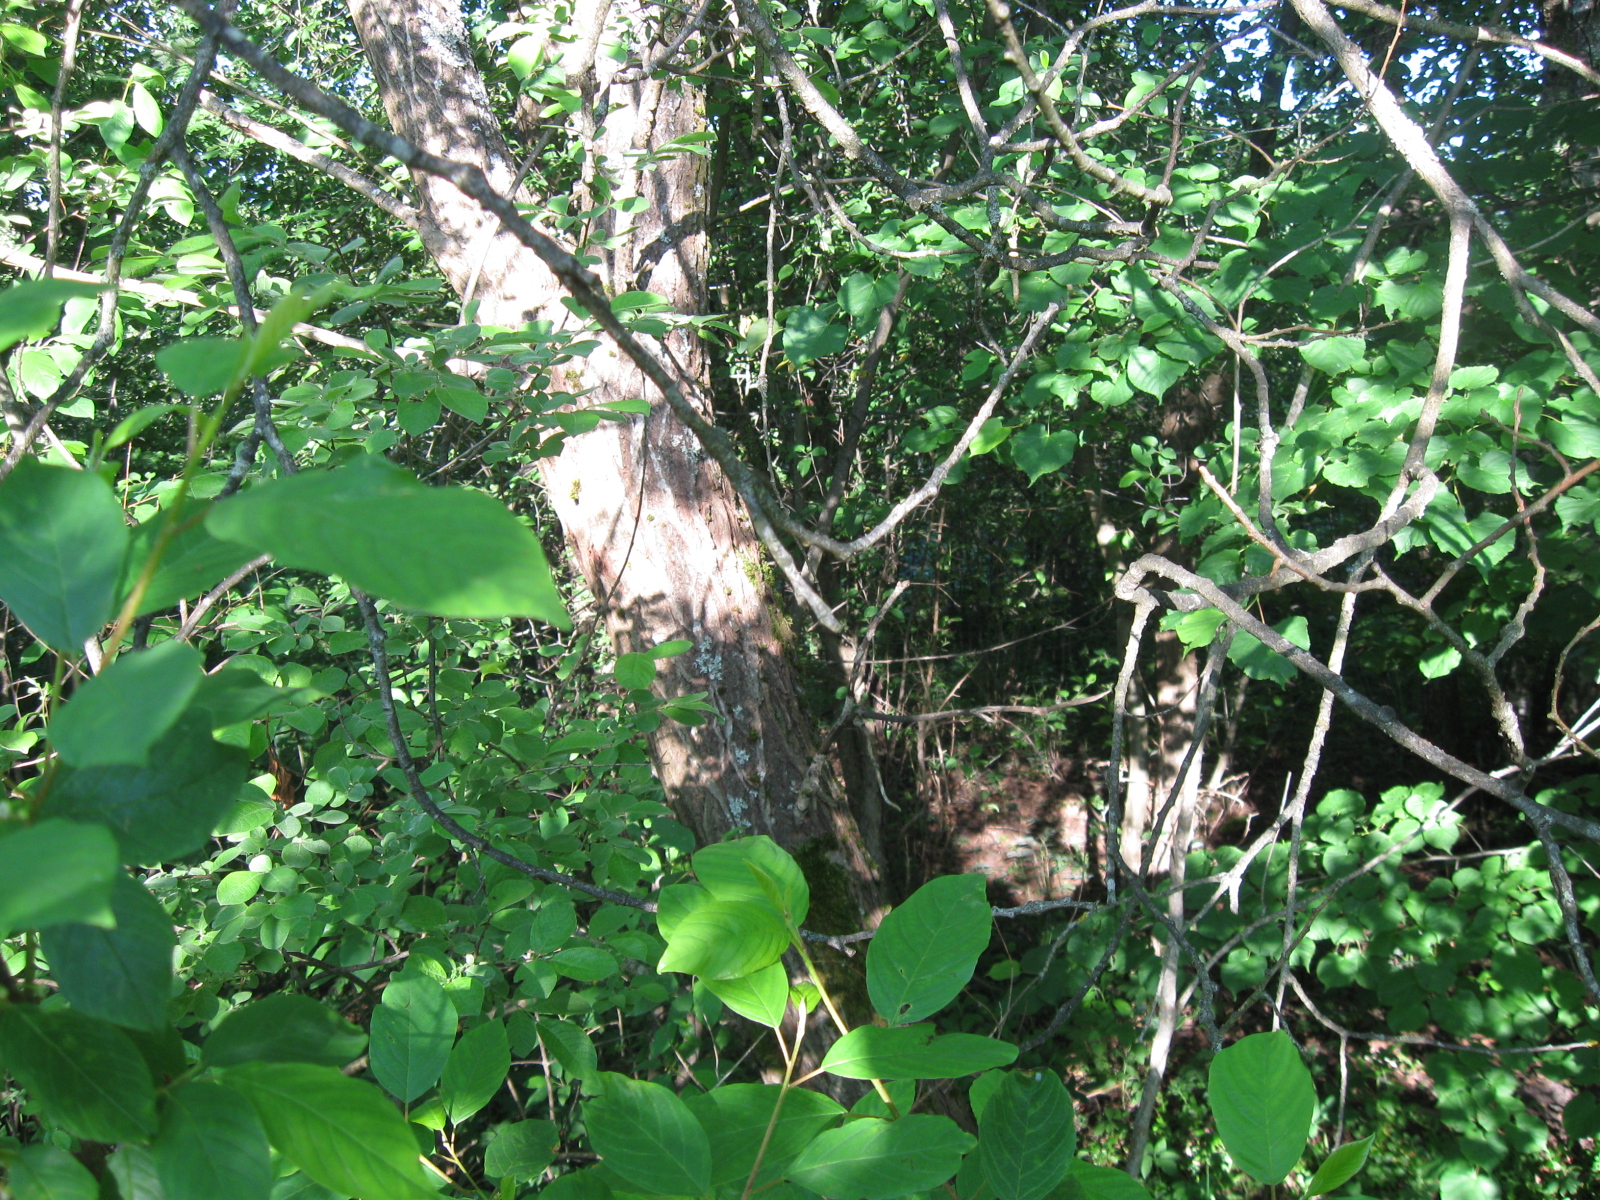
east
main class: Woodland
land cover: Broadleaved woodland
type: non-riverine alder, birch or aspen forest
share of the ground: > 75 %
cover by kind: broadleaved forest trees 95 %, herbaceous plants 5 %
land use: Forestry
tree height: > 5 m
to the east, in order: Broadleaved woodland; Ditches and canals; Spontaneously vegetated surfaces; Grassland with sparse tree/shrub cover; Spontaneously vegetated surfaces; Broadleaved woodland; Spontaneously vegetated surfaces; Other fruit trees and berries; Apple fruit; Grassland without tree/shrub cover; Electric lines; Grassland without tree/shrub cover; Electric lines; Grassland without tree/shrub cover; Tracks; Grassland with sparse tree/shrub cover; Pine dominated mixed woodland
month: June
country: LT
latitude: 54.1624
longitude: 24.7040
